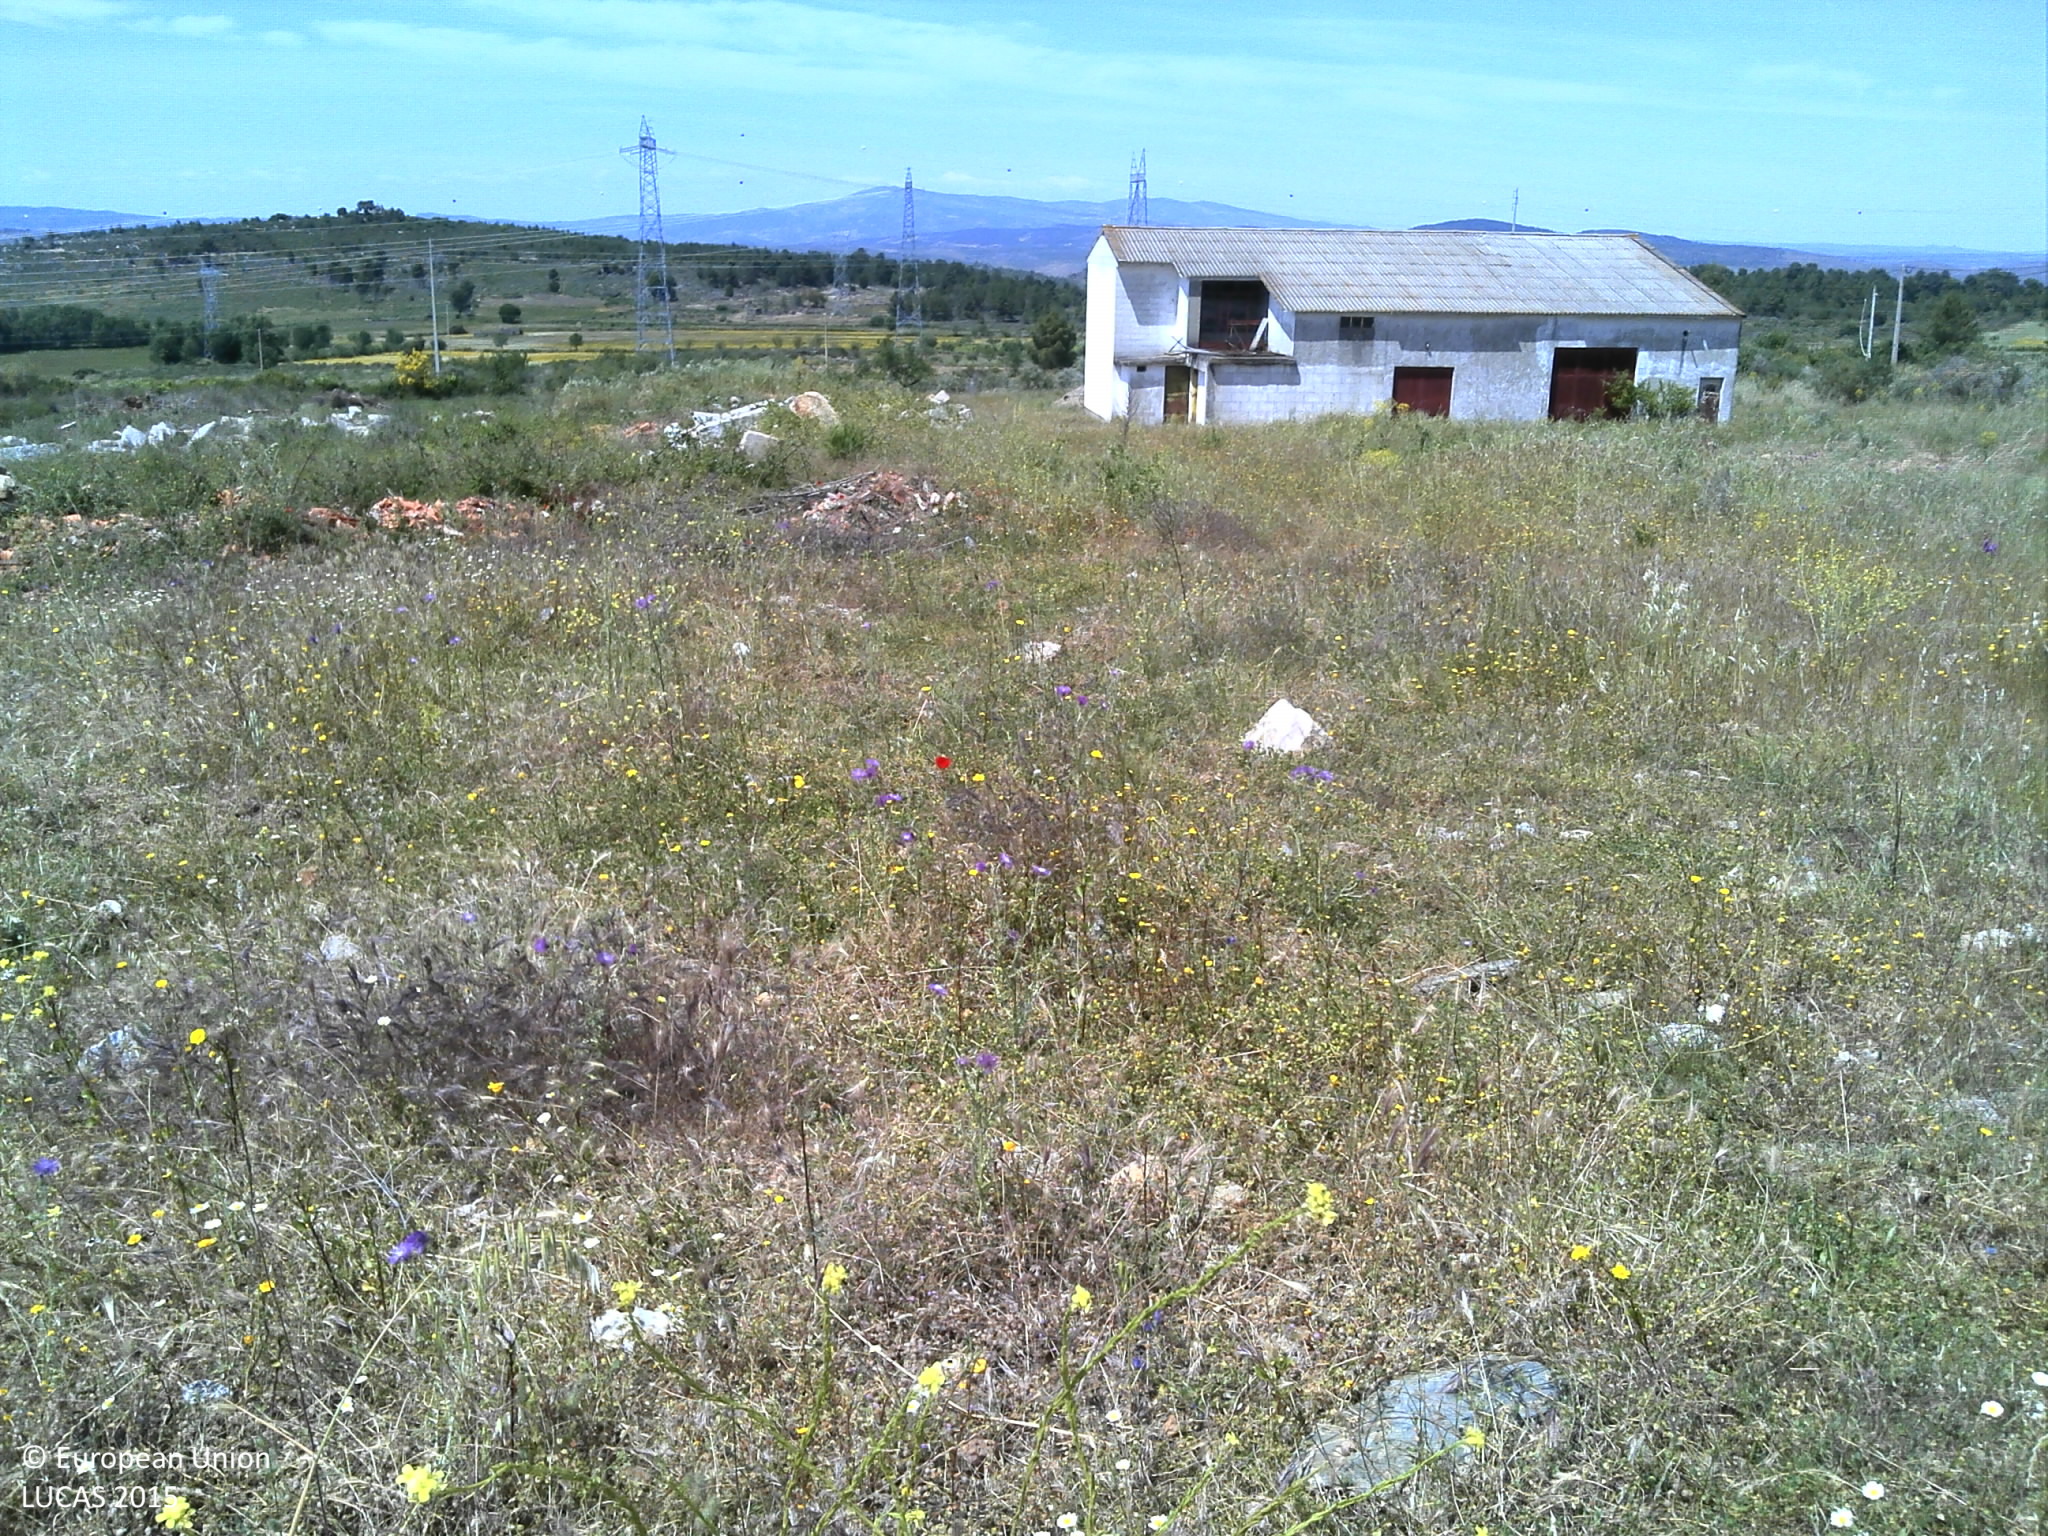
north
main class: Grassland
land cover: Grassland without tree/shrub cover
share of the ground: > 75 %
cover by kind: herbaceous plants 95 %, unconsolidated bare surface 5 %
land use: Agriculture (excluding fallow land and kitchen gardens)
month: May
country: PT
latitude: 41.1855
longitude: -7.0033
